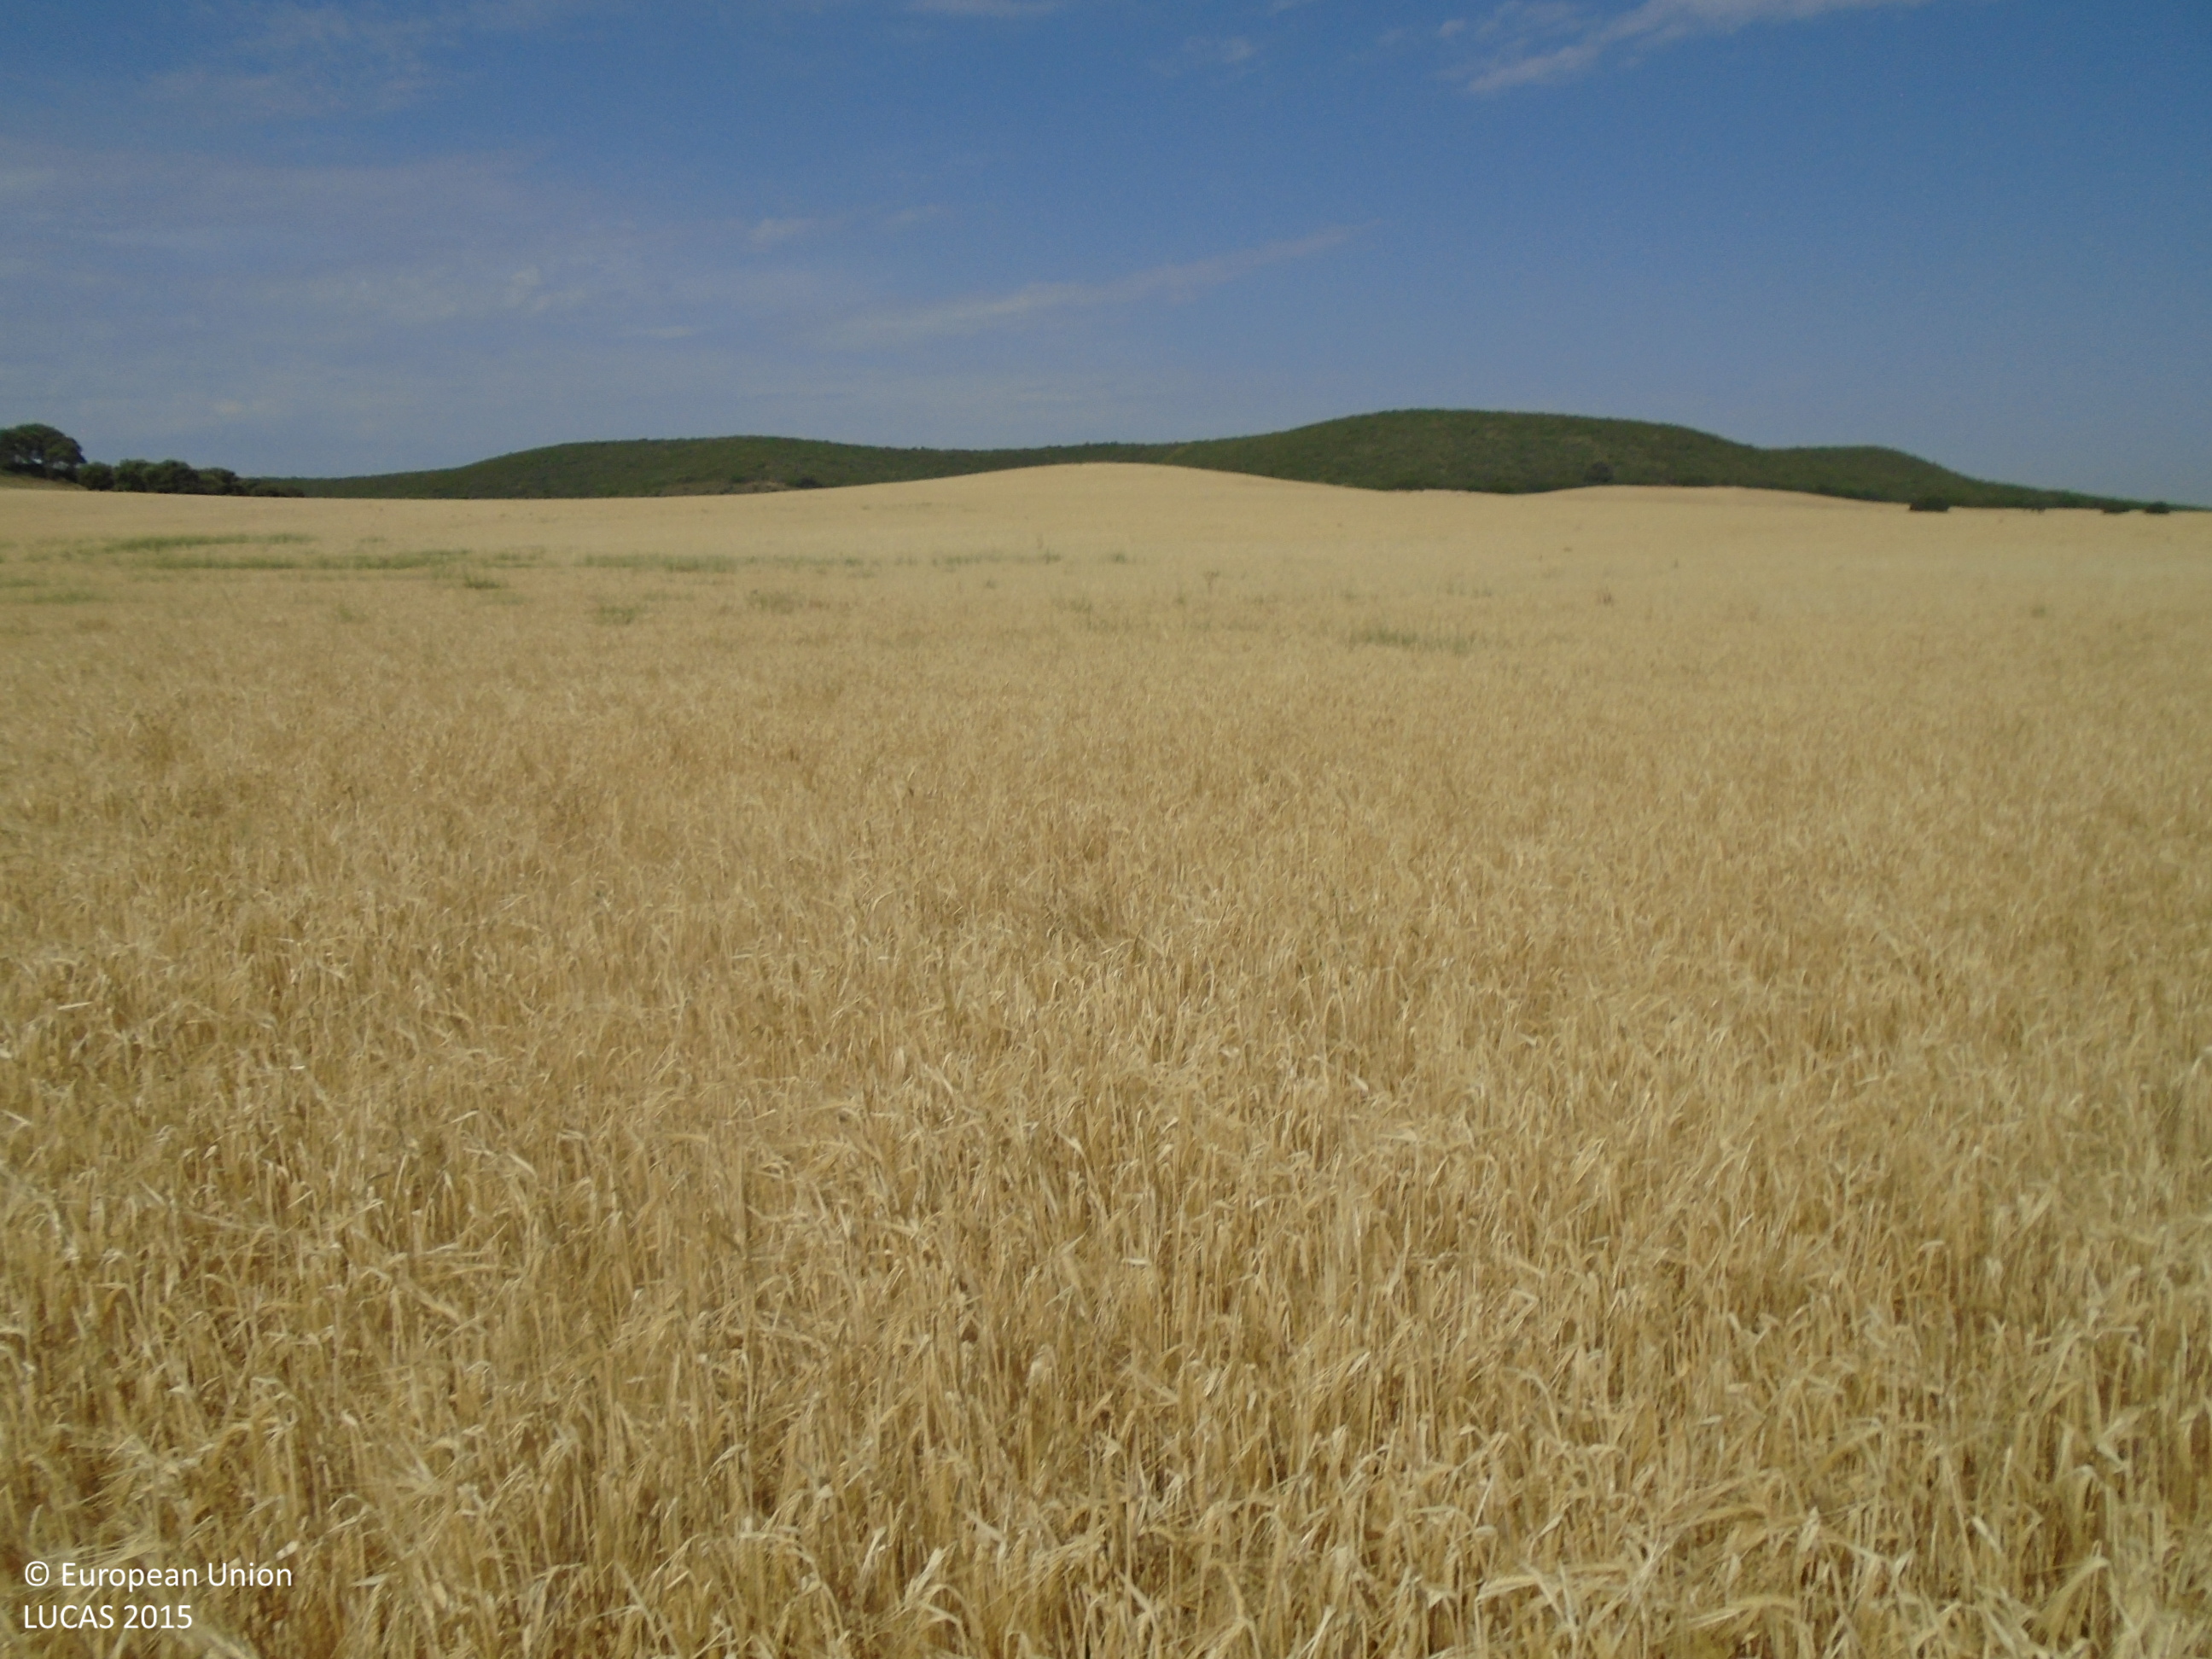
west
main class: Cropland
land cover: Barley
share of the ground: > 75 %
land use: Agriculture (excluding fallow land and kitchen gardens)
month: June
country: ES
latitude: 39.8112
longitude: -4.2292
